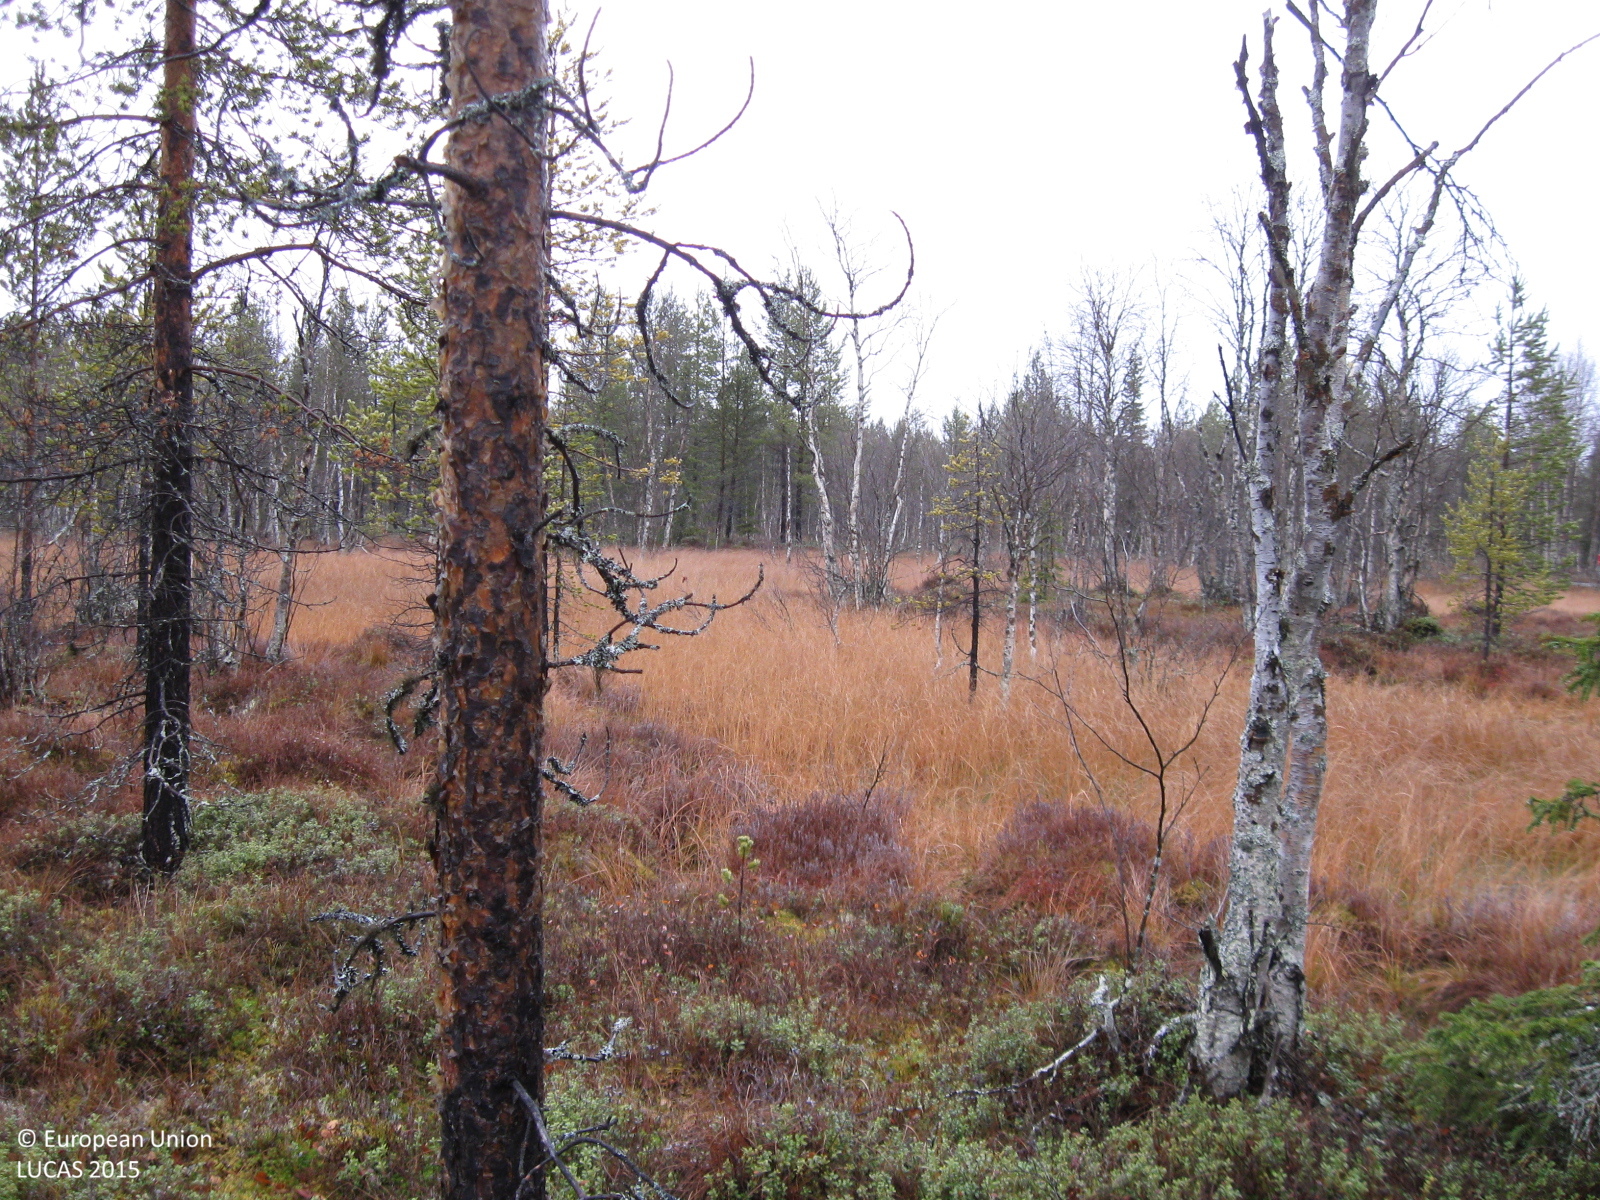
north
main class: Woodland
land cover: Pine dominated mixed woodland
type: mire and swamp forests
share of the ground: 25 - 50 %
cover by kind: herbaceous plants 35 %, shrubs 20 %, coniferous forest trees 15 %, broadleaved forest trees 15 %, lichens and mosses 15 %
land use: Semi-natural and natural areas not in use
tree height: > 5 m
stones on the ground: < 10 %
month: October
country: SE
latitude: 66.7399
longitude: 21.0074
